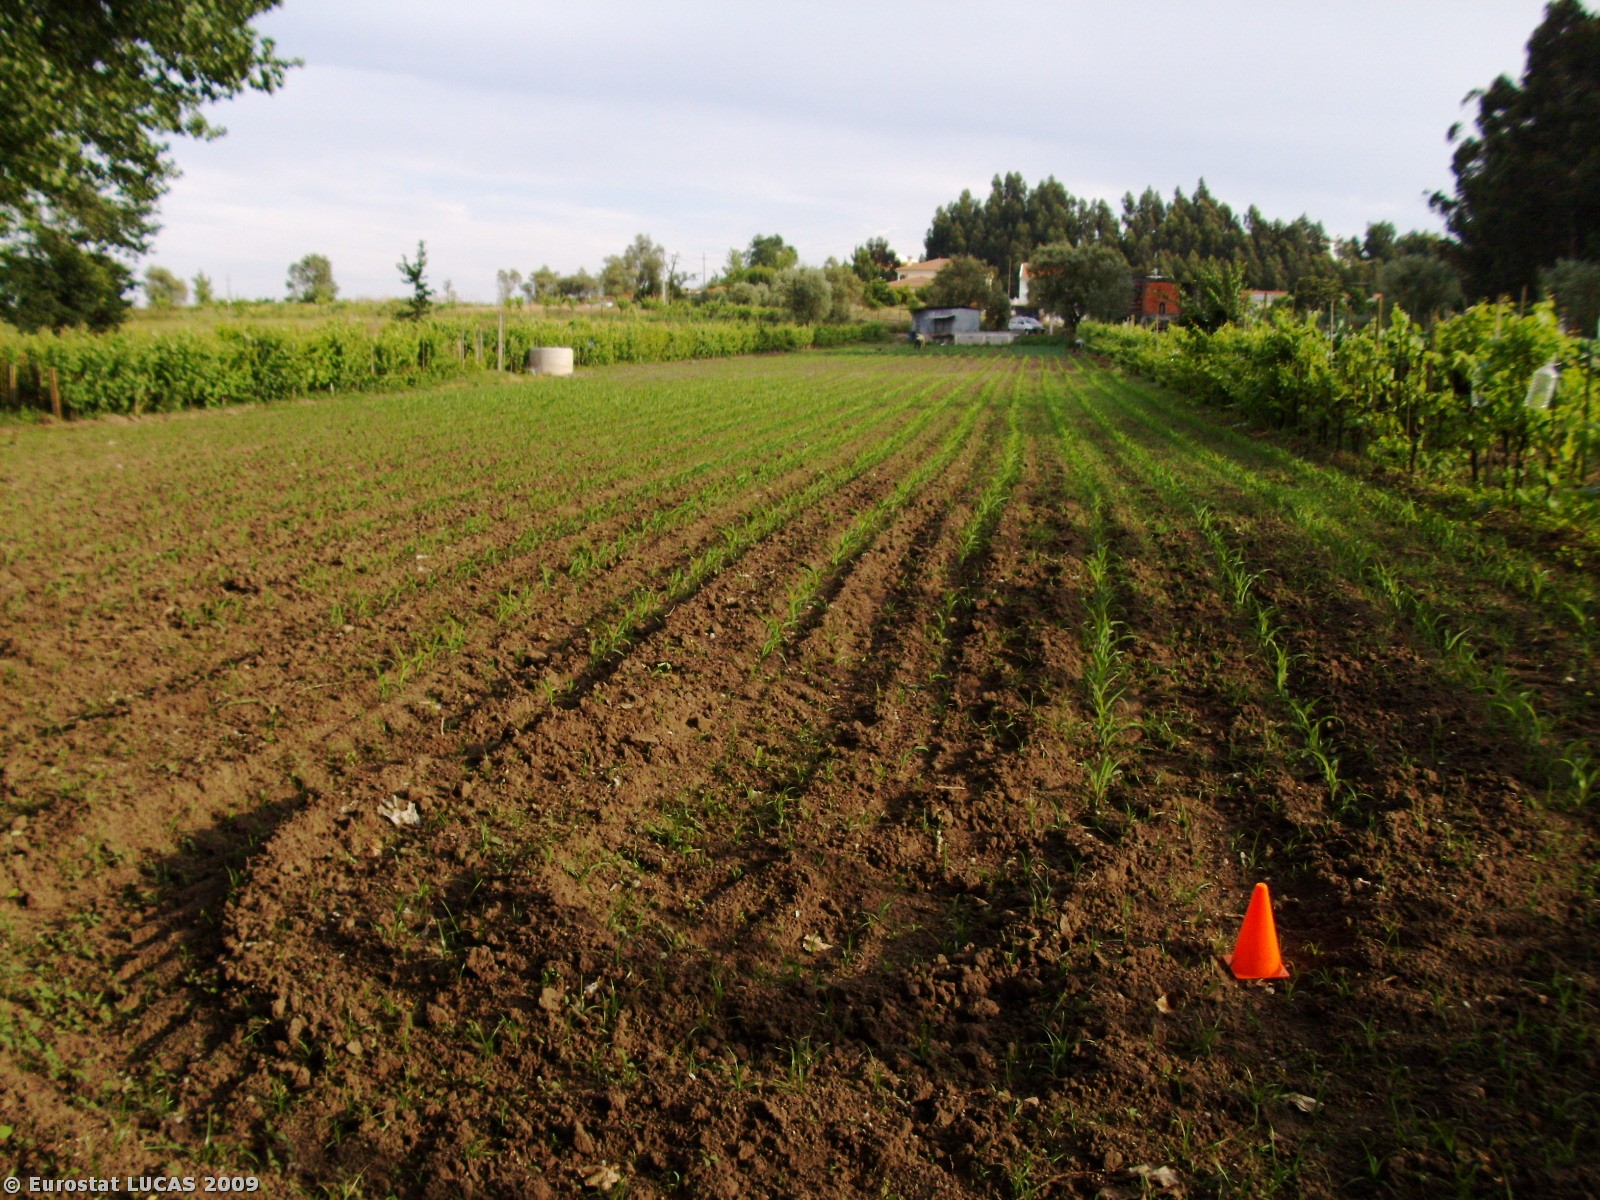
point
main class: Cropland
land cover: Maize
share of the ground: 50 - 75 %
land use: Agriculture (excluding fallow land and kitchen gardens)
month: May
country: PT
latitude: 40.5746
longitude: -8.5328
